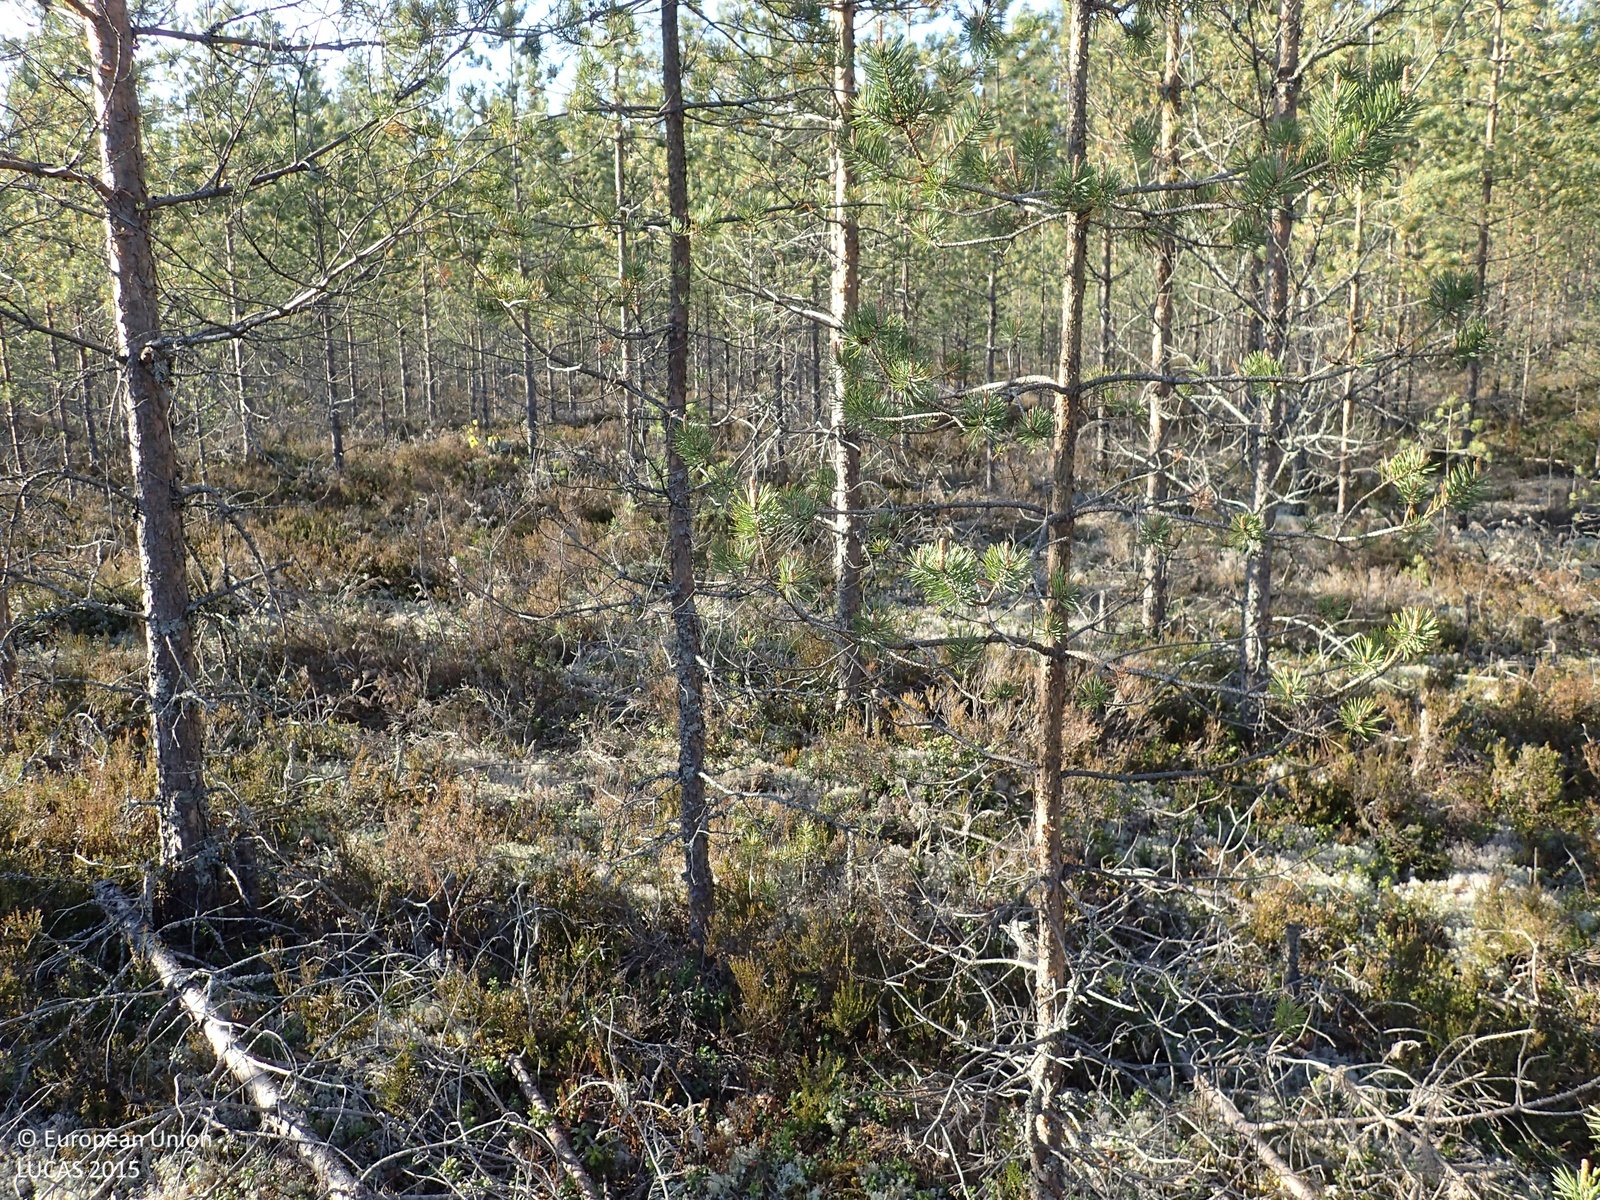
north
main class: Woodland
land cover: Pine dominated coniferous woodland
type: boreal forest
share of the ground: > 75 %
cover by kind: coniferous forest trees 75 %, shrubs 20 %, lichens and mosses 5 %
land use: Forestry
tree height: > 5 m
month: June
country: FI
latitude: 62.3023
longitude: 21.9099
